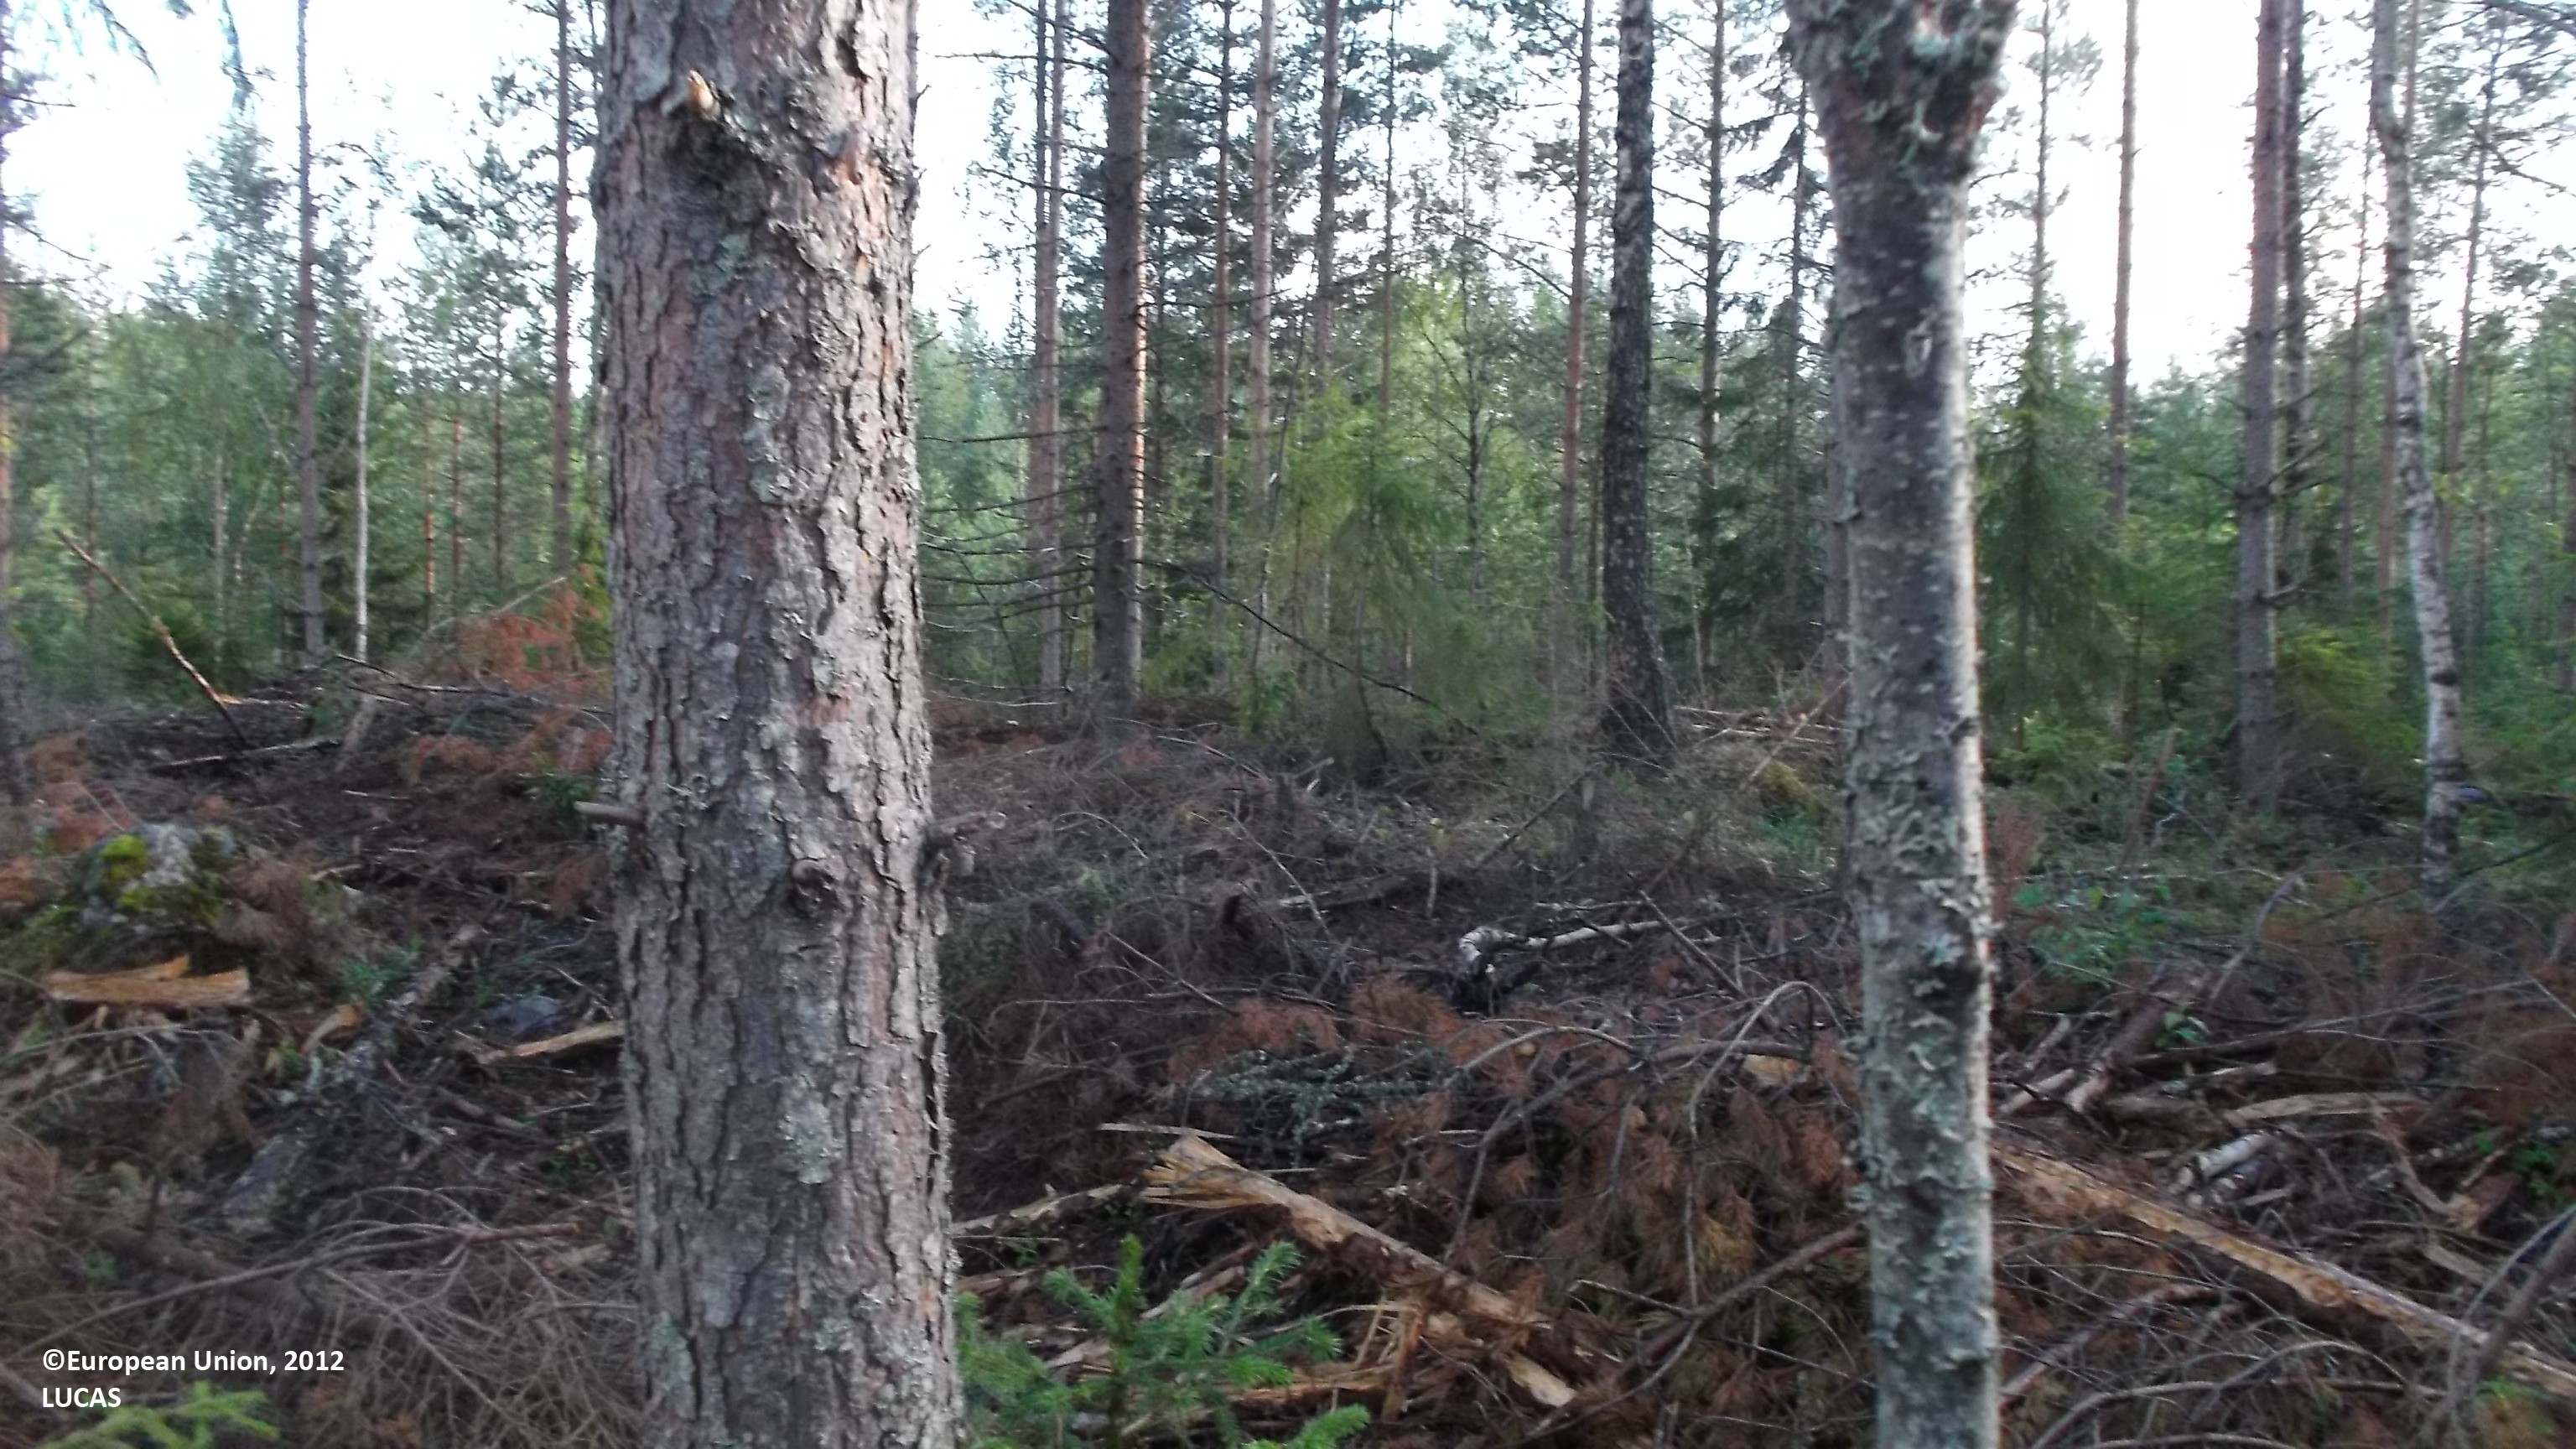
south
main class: Woodland
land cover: Pine dominated mixed woodland
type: boreal forest
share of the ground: 25 - 50 %
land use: Forestry
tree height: > 5 m
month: August
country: FI
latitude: 63.9246
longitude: 23.3296
